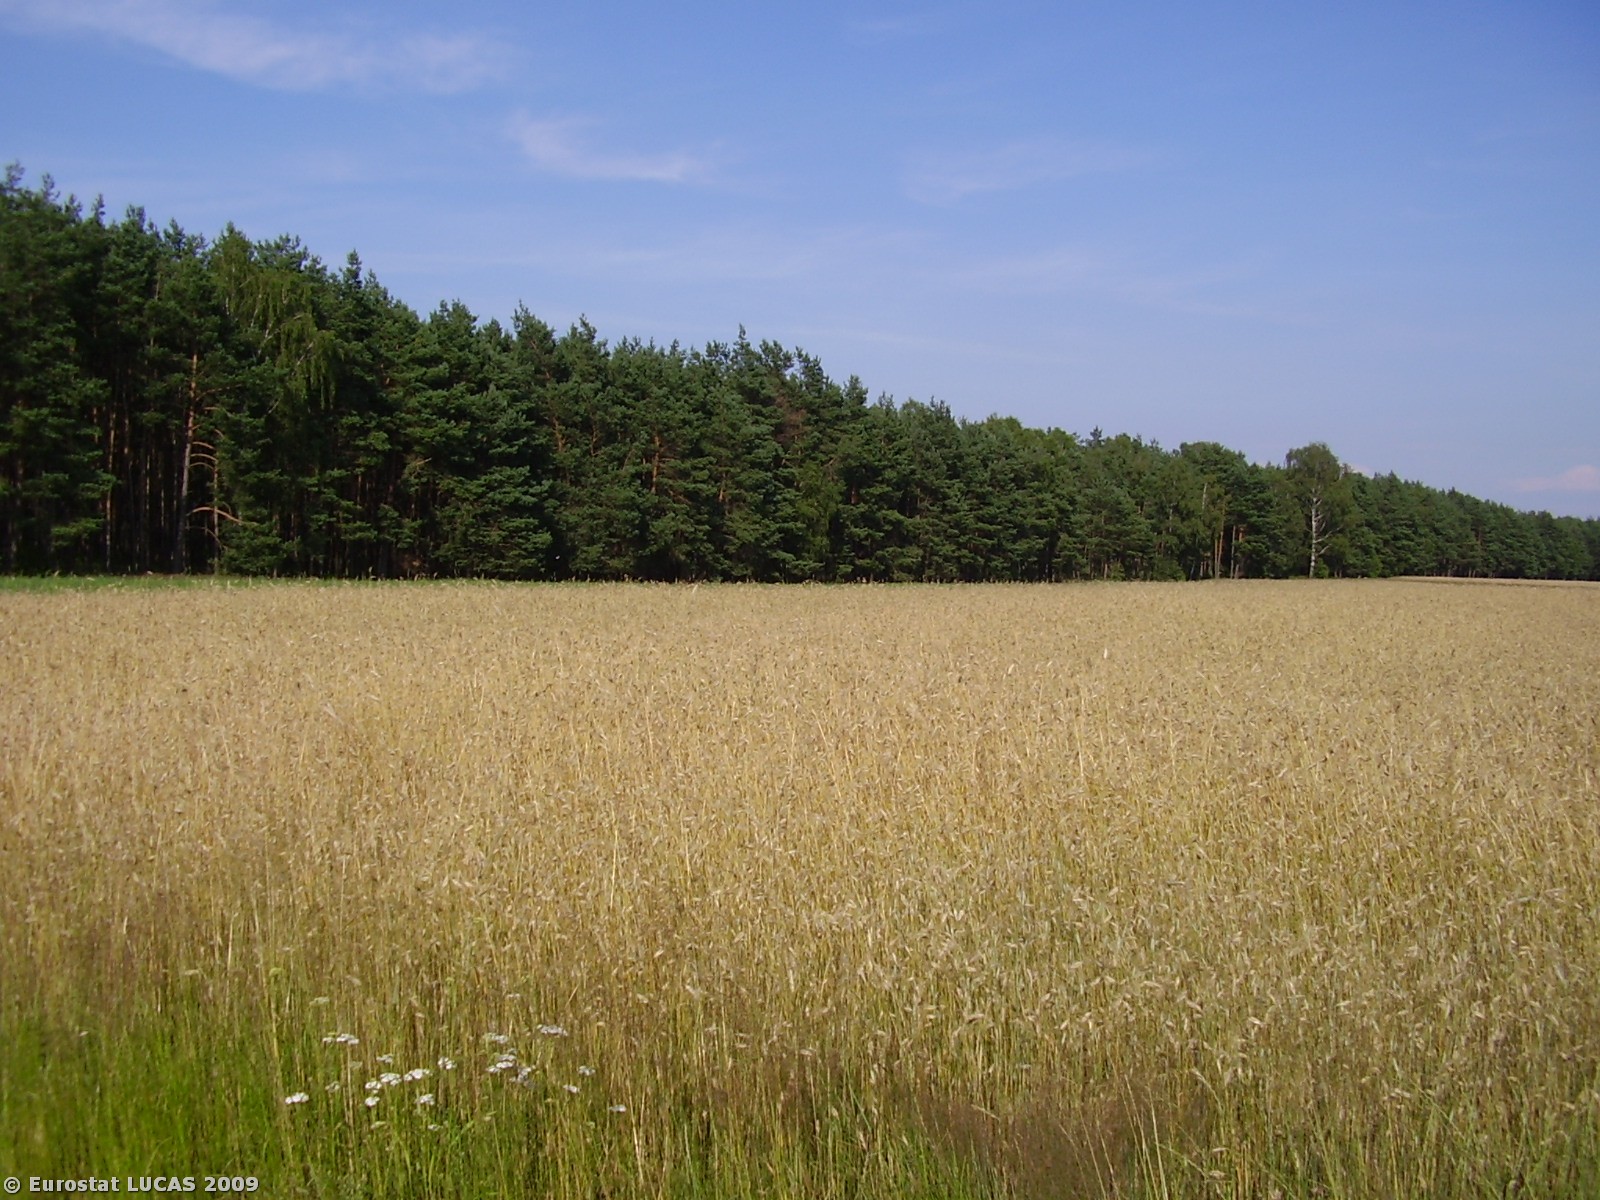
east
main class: Cropland
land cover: Triticale
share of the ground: > 75 %
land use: Agriculture (excluding fallow land and kitchen gardens)
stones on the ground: < 10 %
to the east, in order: Triticale; Tracks; Triticale; Other leguminous and mixtures for fodder
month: July
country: PL
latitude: 51.3693
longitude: 17.9591
